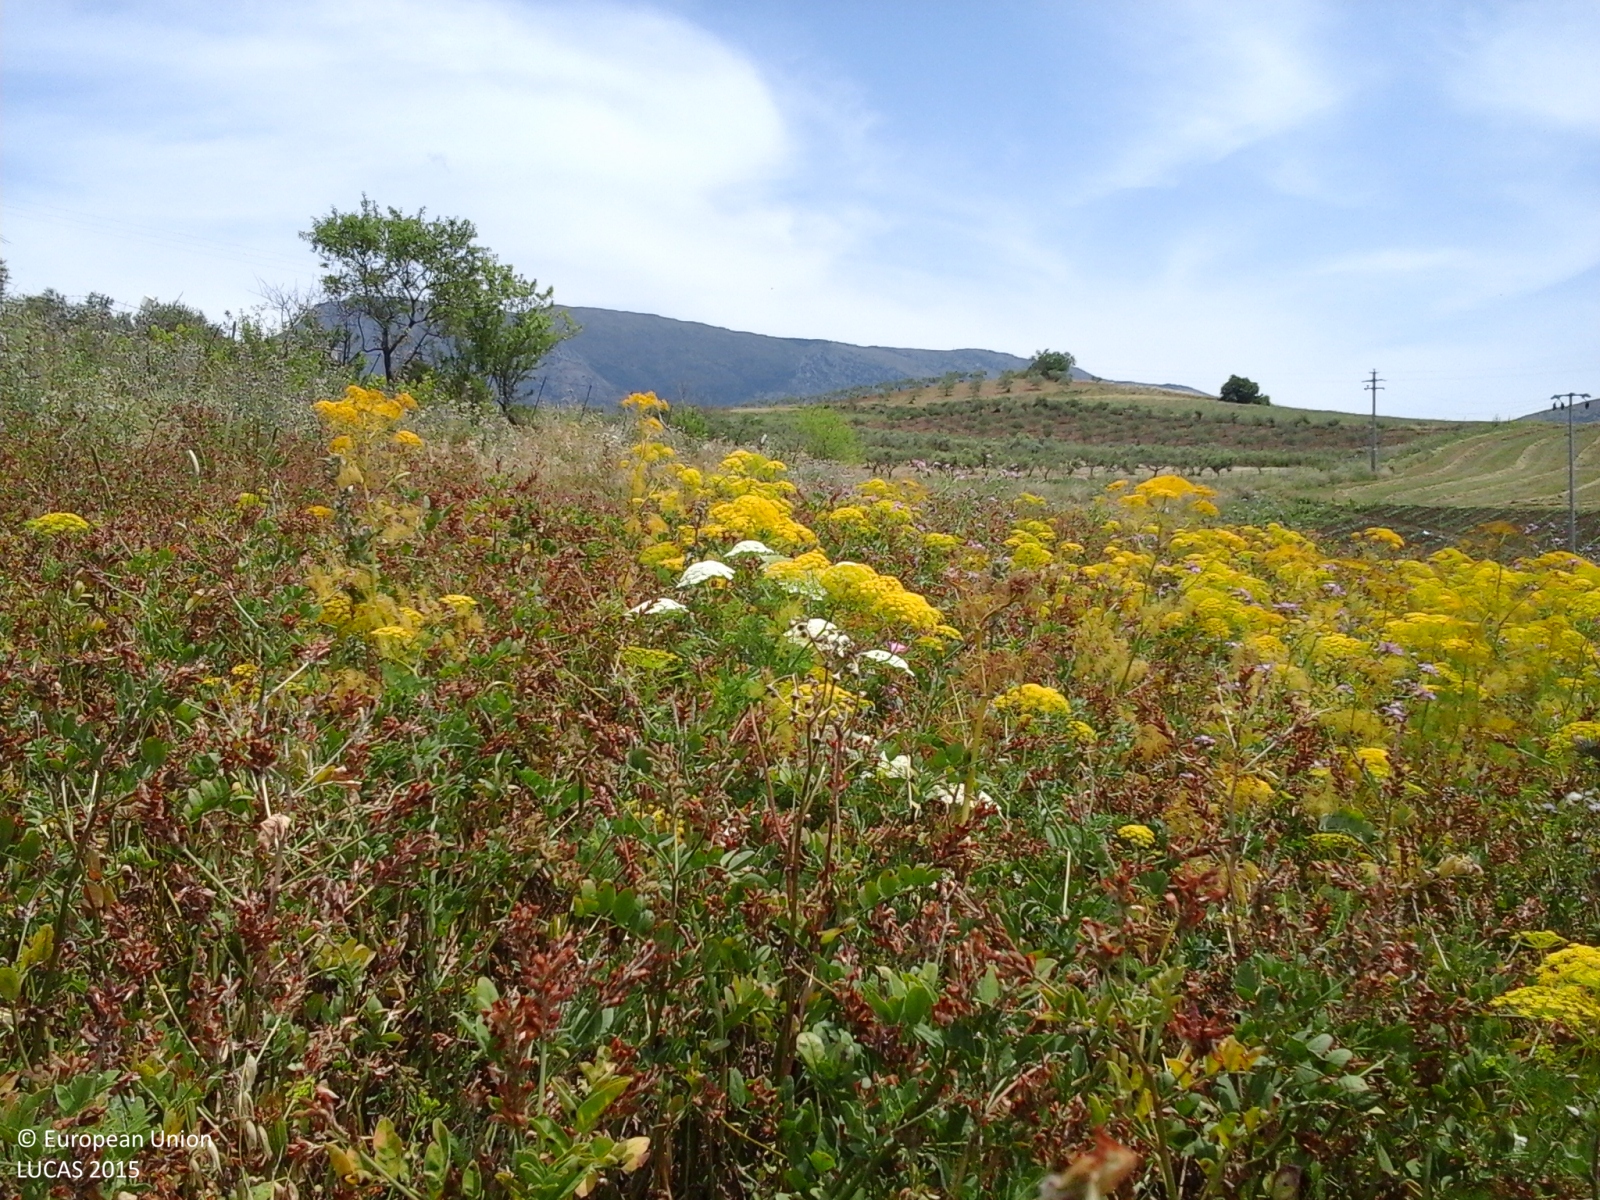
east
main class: Cropland
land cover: Other leguminous and mixtures for fodder
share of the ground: > 75 %
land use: Agriculture (excluding fallow land and kitchen gardens)
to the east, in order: Other leguminous and mixtures for fodder; Tomatoes; Other fresh vegetables; Grass margins; Tracks; Grass margins; Fences; Electric lines; Olive groves; Fences; Spontaneously vegetated surfaces; Fences; Olive groves
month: May
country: IT
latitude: 37.9370
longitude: 13.5135
